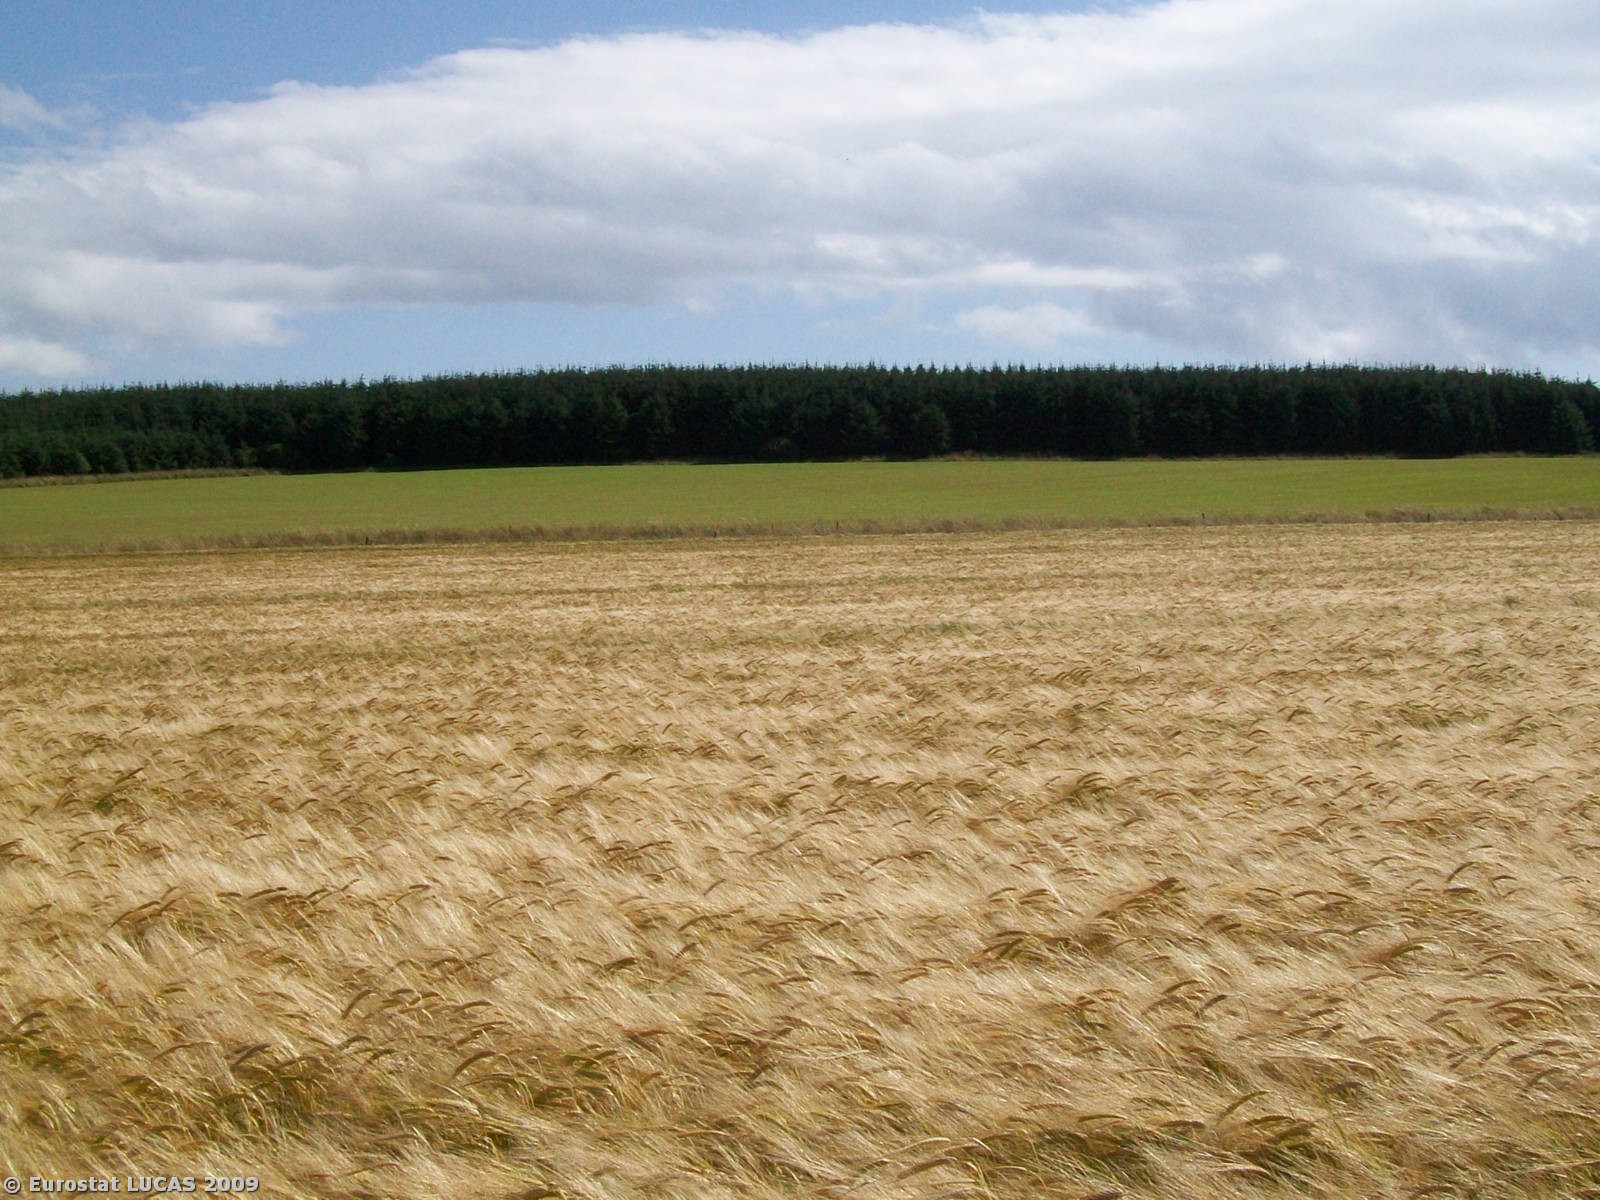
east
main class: Cropland
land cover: Barley
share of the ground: > 75 %
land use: Agriculture (excluding fallow land and kitchen gardens)
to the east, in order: Barley; Grass margins; Fences; Grass margins; Tracks; Grass margins; Ditches and canals; Grass margins; Fences; Grassland without tree/shrub cover
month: August
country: GB
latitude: 56.8438
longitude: -2.3655
